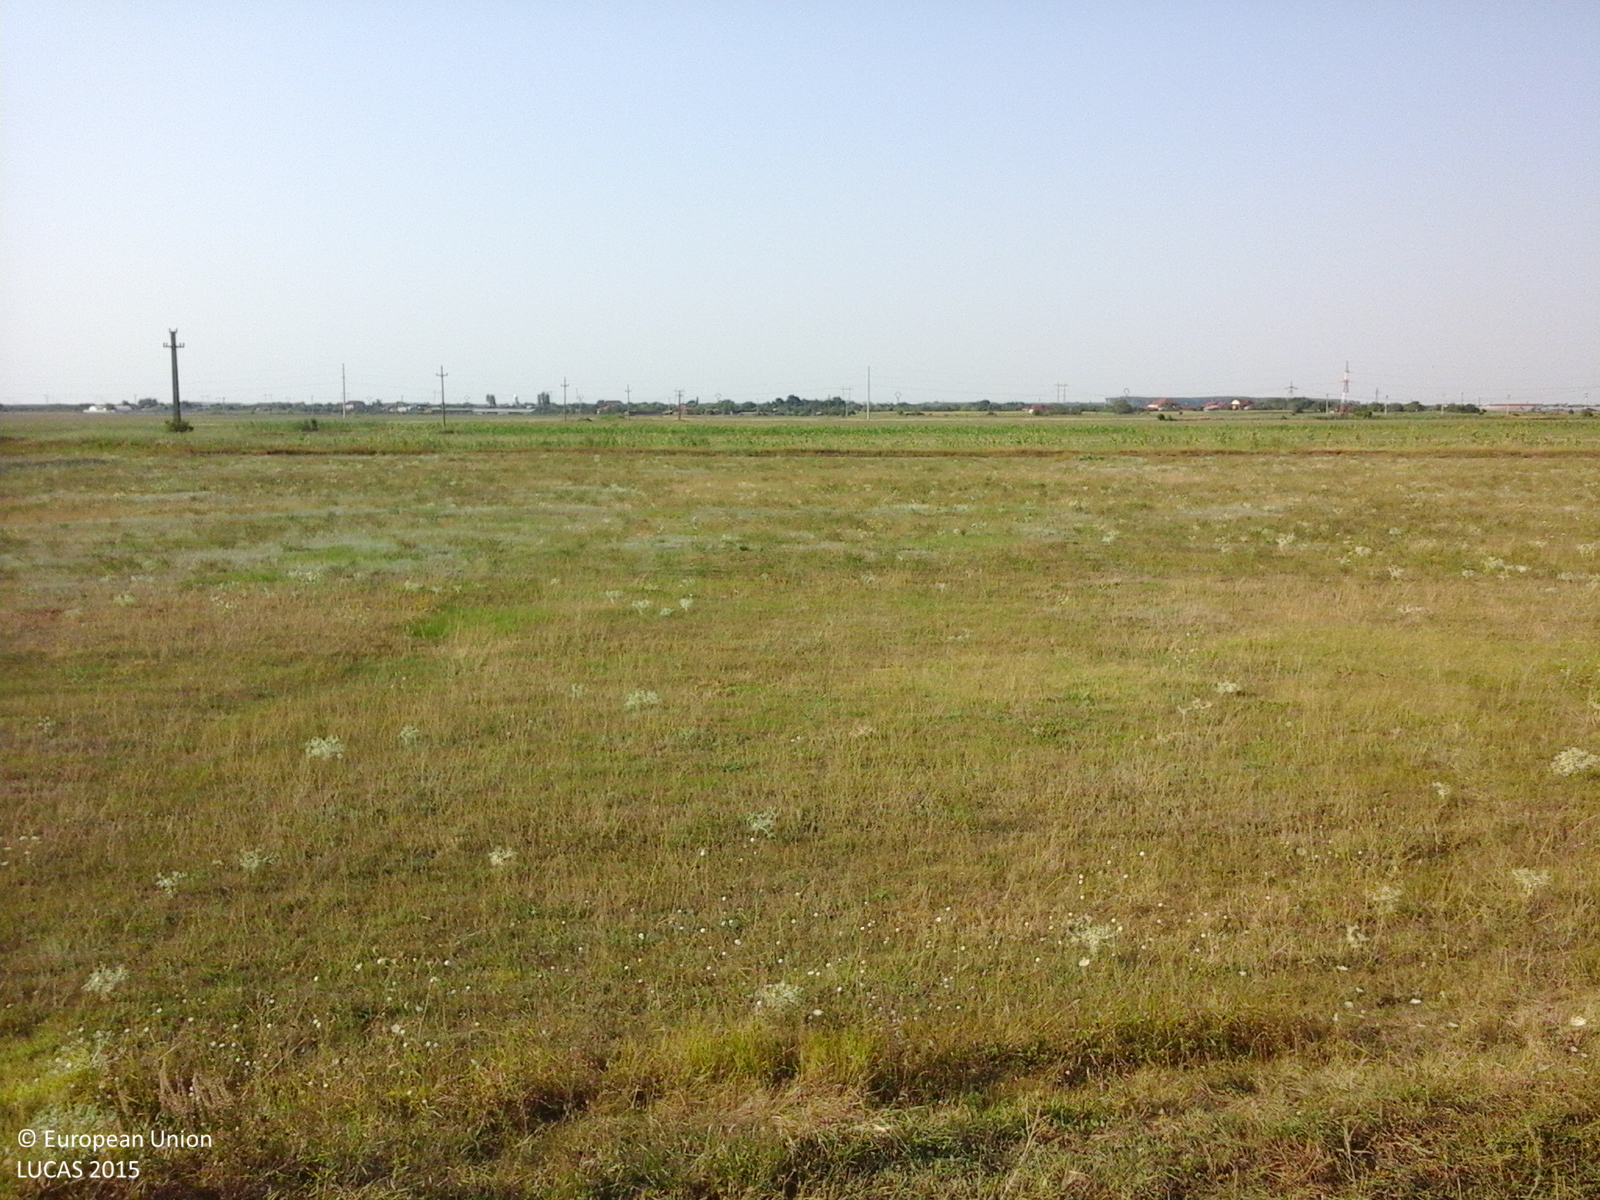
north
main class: Grassland
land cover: Grassland without tree/shrub cover
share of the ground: > 75 %
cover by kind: herbaceous plants 100 %
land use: Agriculture (excluding fallow land and kitchen gardens)
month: August
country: RO
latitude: 45.5765
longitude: 27.4928
